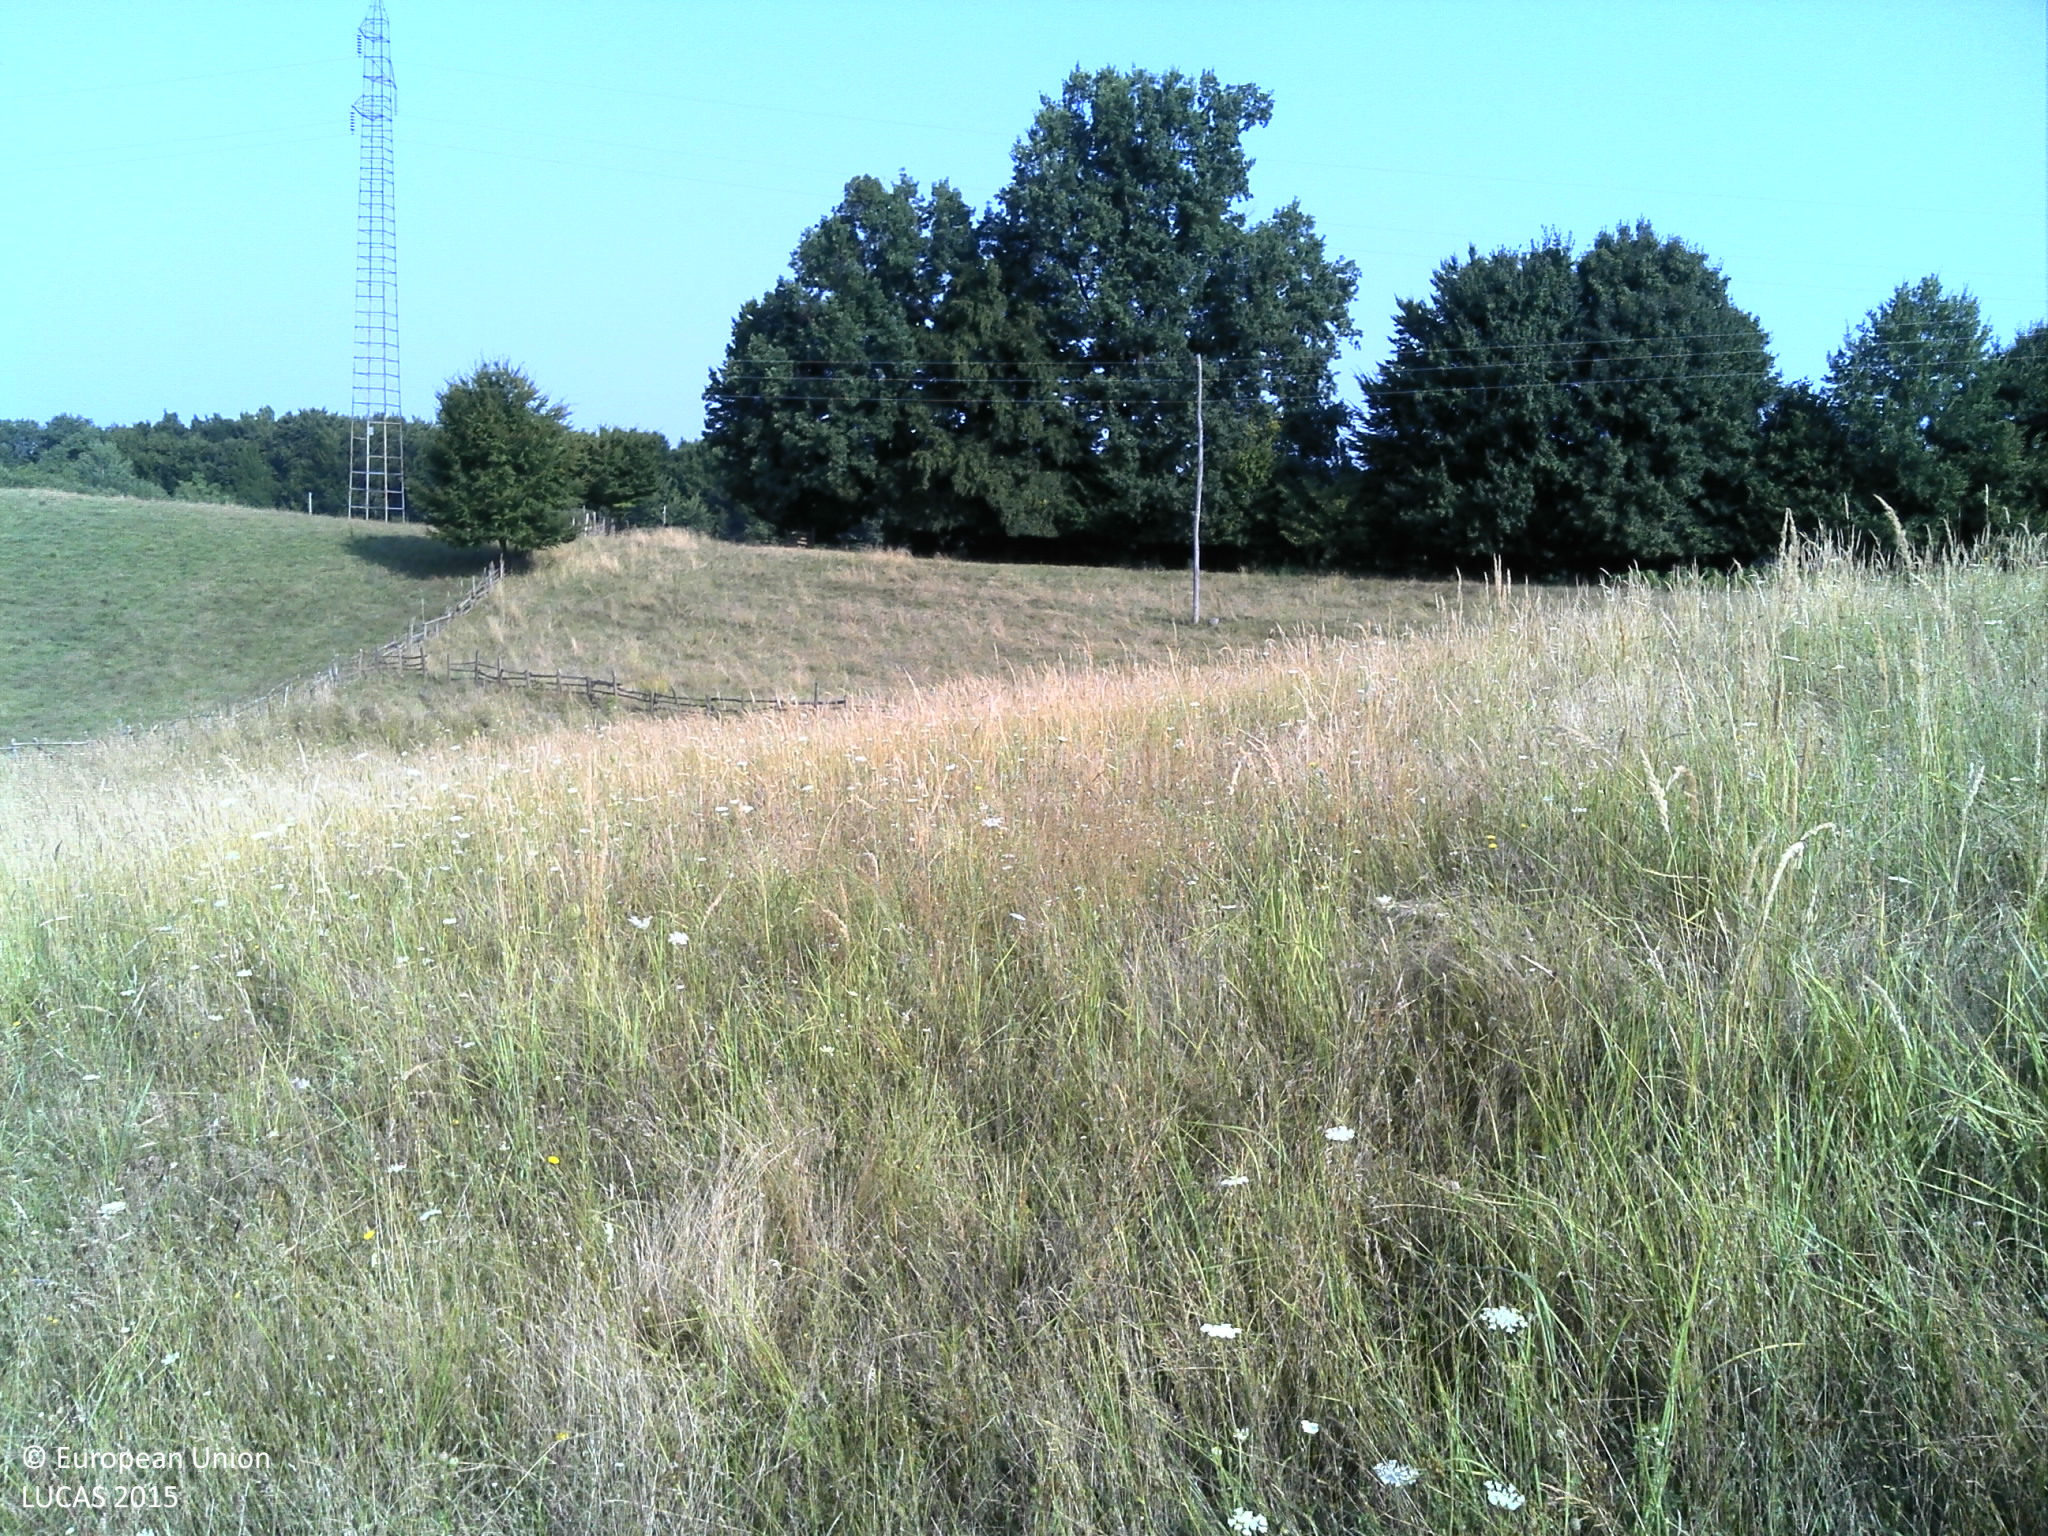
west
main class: Grassland
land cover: Spontaneously vegetated surfaces
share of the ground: > 75 %
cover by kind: herbaceous plants 100 %
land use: Semi-natural and natural areas not in use
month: August
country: HR
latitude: 45.7228
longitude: 17.2865
